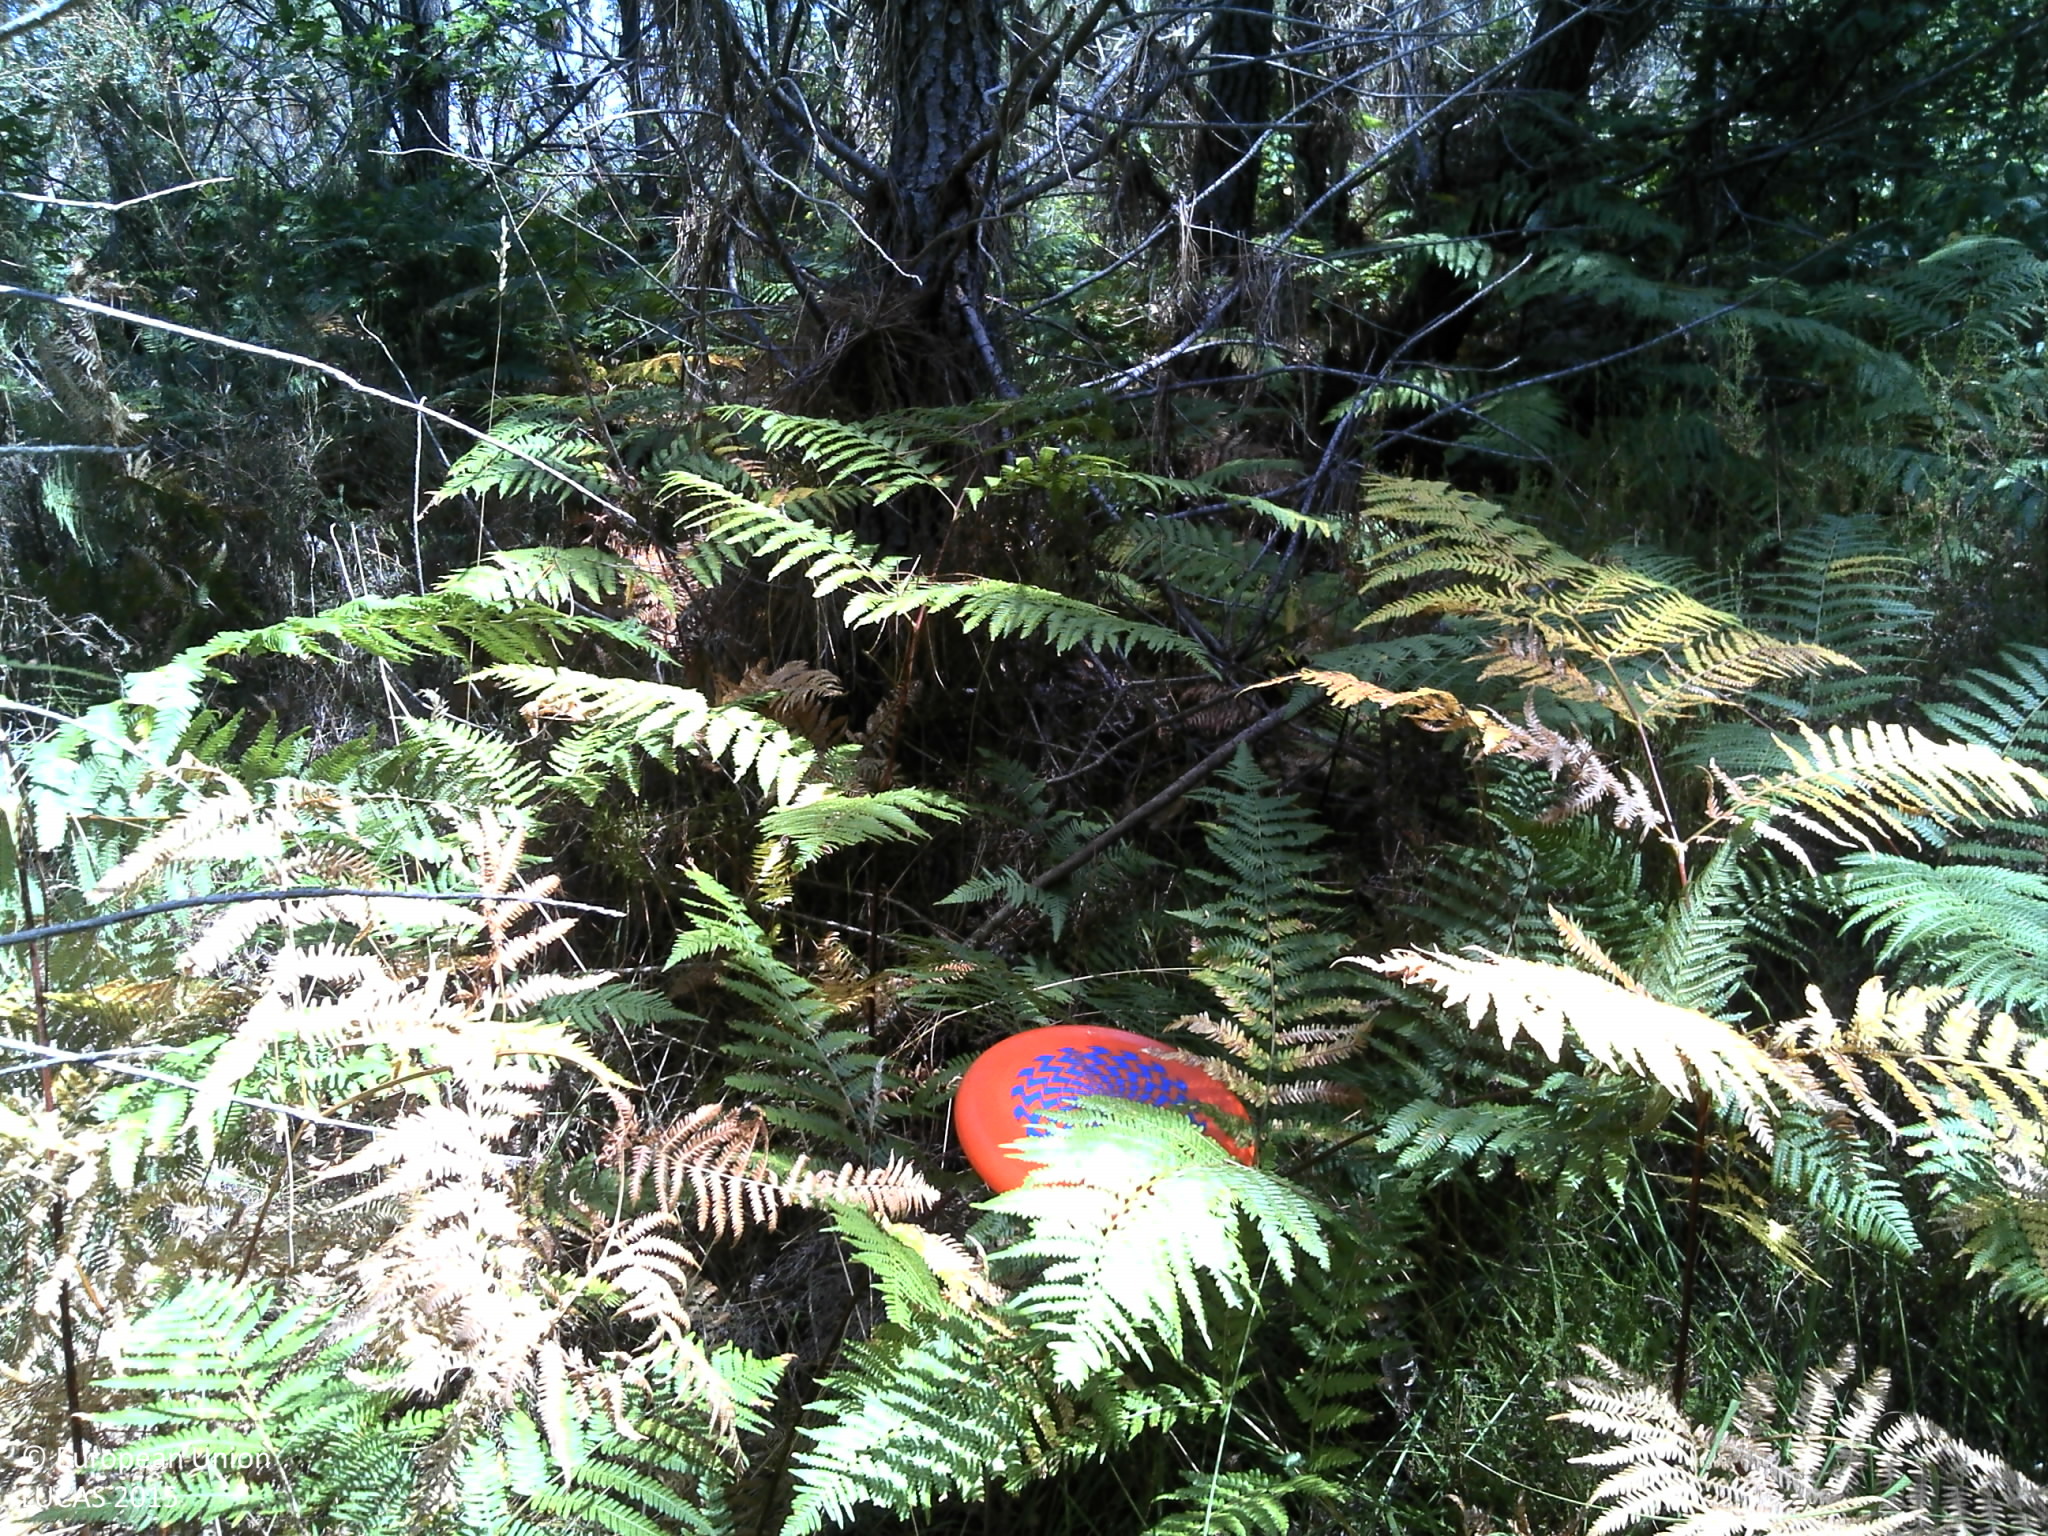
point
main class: Woodland
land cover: Pine dominated coniferous woodland
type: coniferous forest of the mediterranean region
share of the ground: > 75 %
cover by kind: coniferous forest trees 60 %, shrubs 30 %, herbaceous plants 5 %, lichens and mosses 5 %
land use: Forestry
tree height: > 5 m
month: August
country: FR
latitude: 44.9830
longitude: -0.9935
